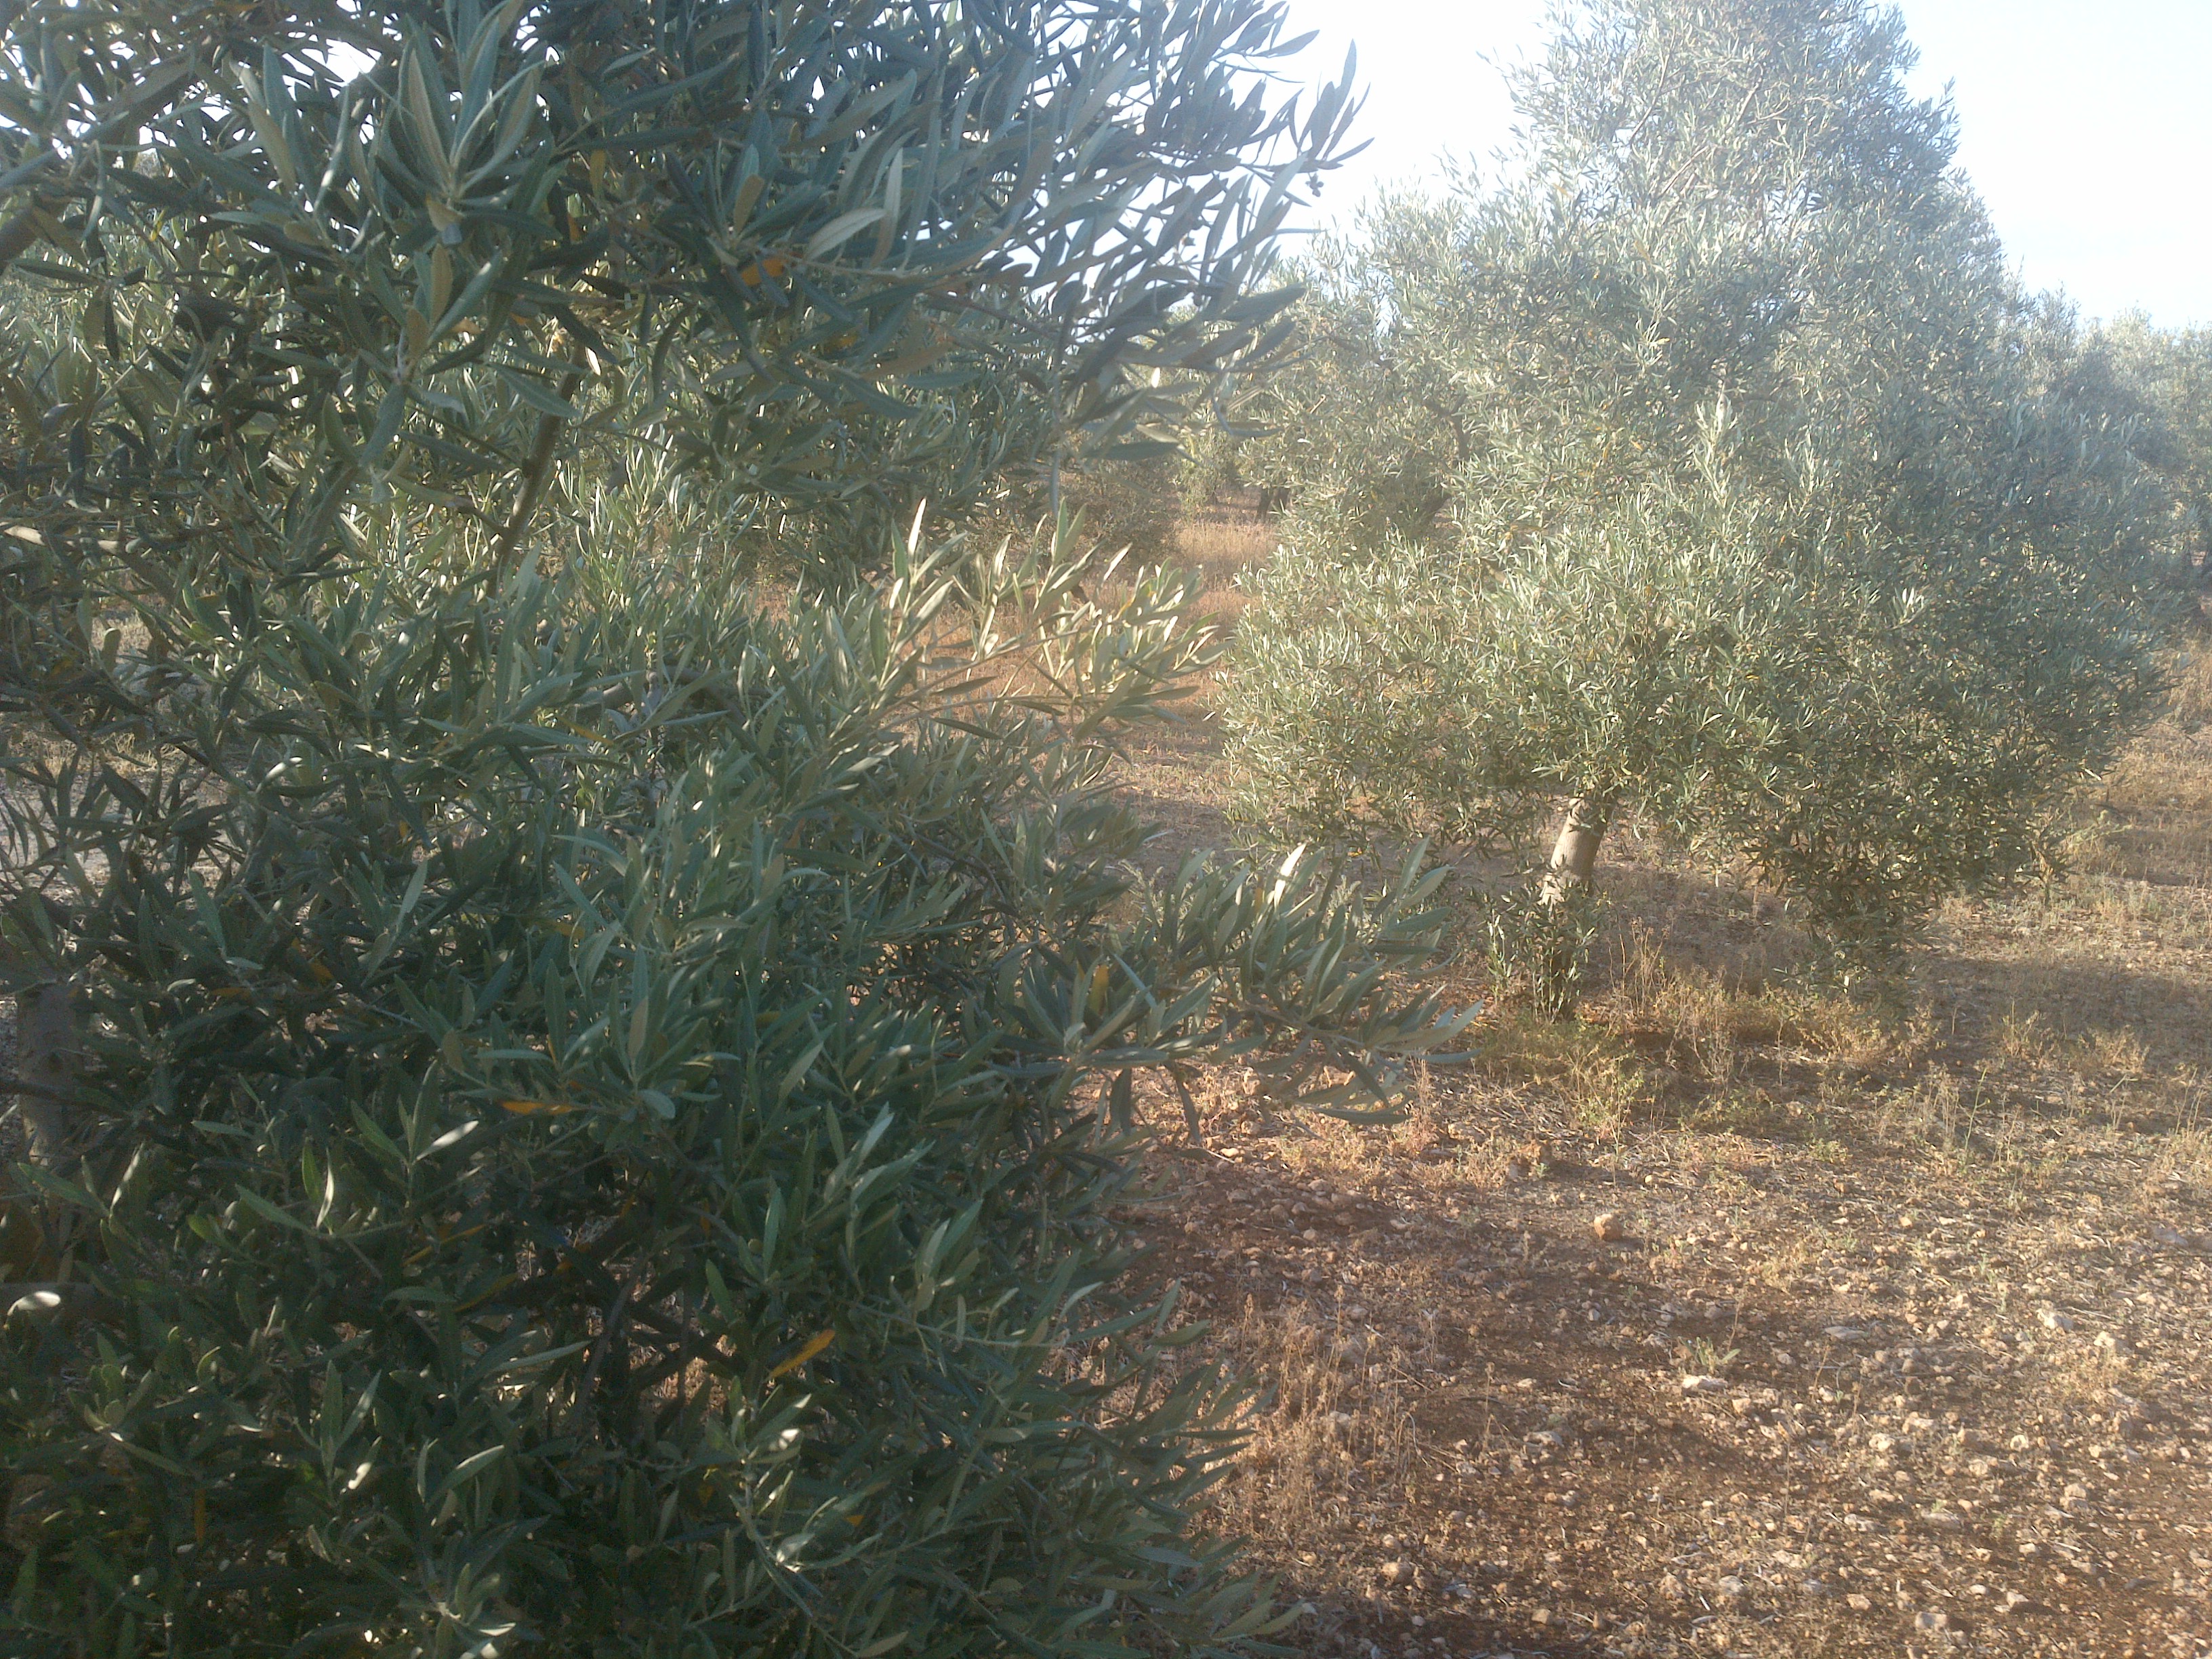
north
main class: Cropland
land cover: Olive groves
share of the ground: 50 - 75 %
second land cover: Other bare soil
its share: > 75 %
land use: Agriculture (excluding fallow land and kitchen gardens)
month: May
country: ES
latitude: 37.3508
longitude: -4.8285
